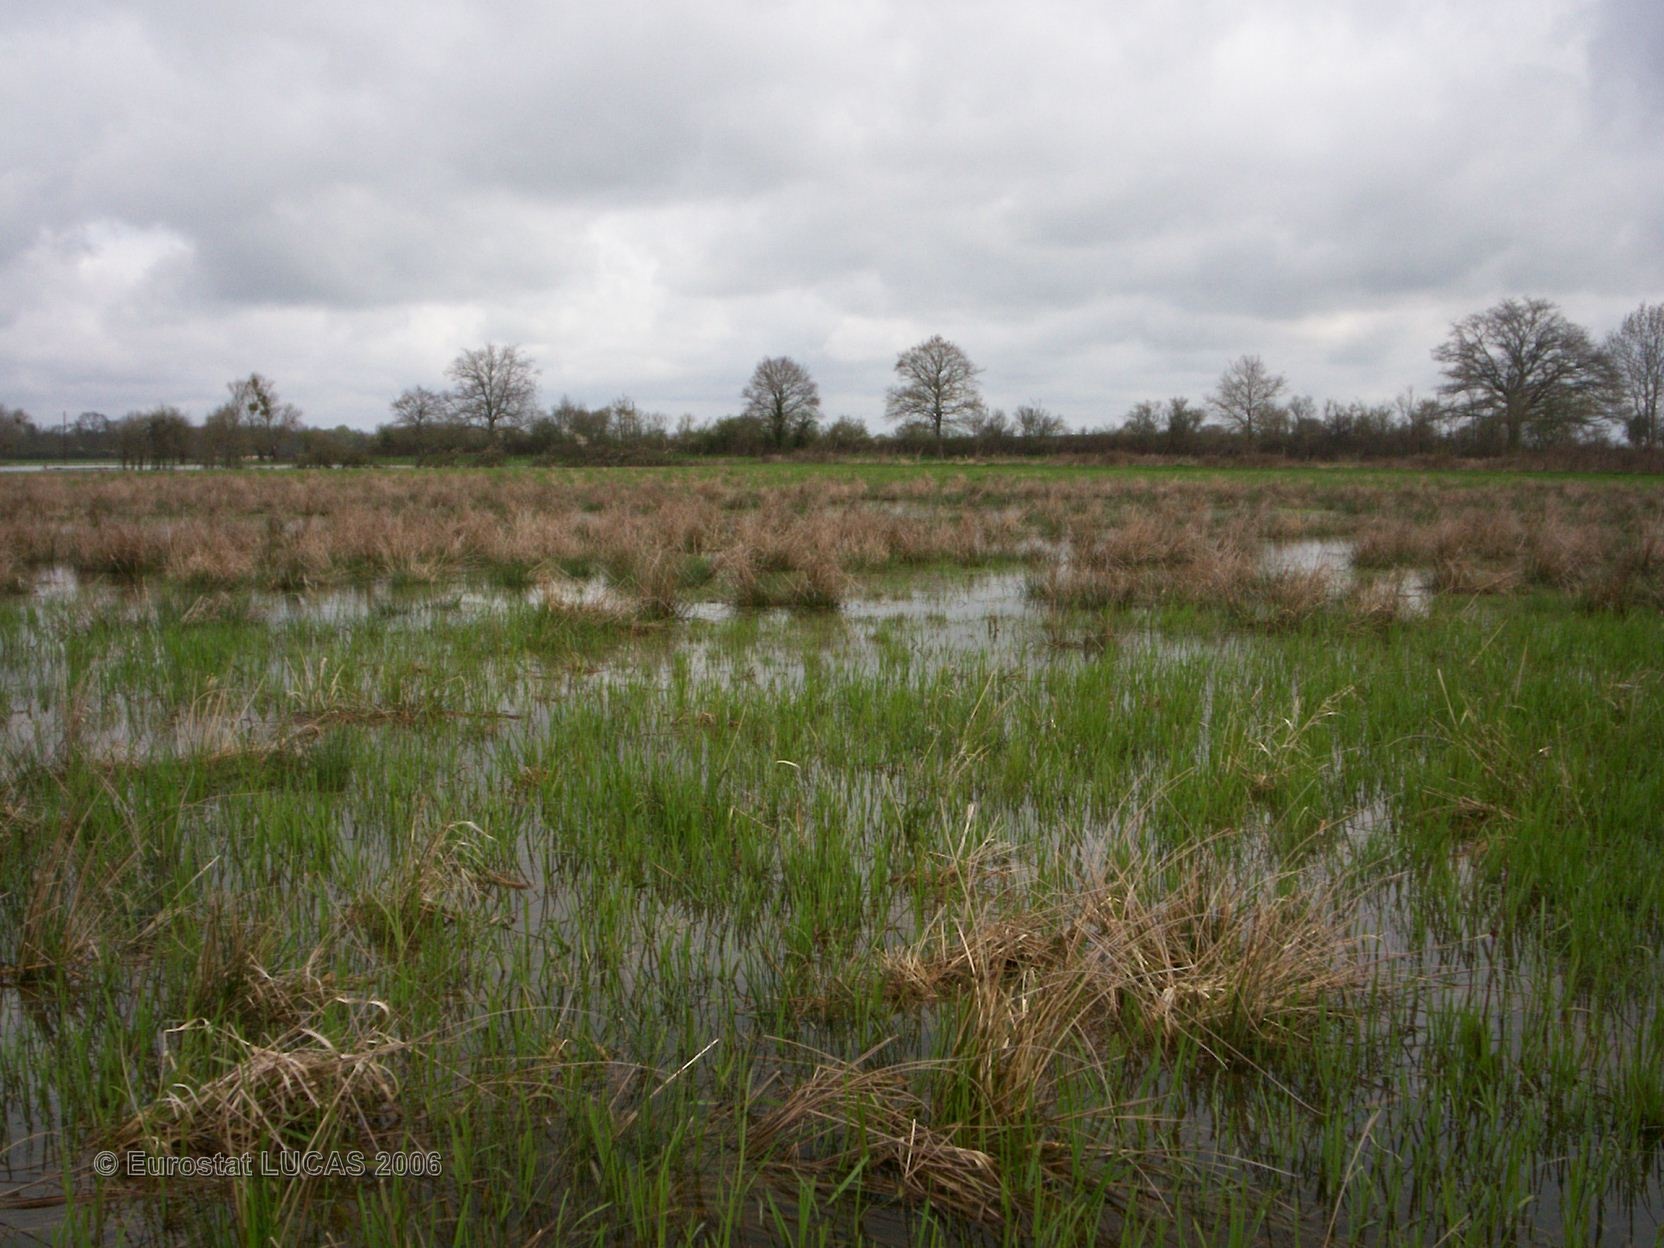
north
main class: Grassland
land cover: Grassland without tree/shrub cover
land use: Agriculture (excluding fallow land and kitchen gardens)
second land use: Wetland
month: April
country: FR
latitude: 46.8127
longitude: 3.0637
